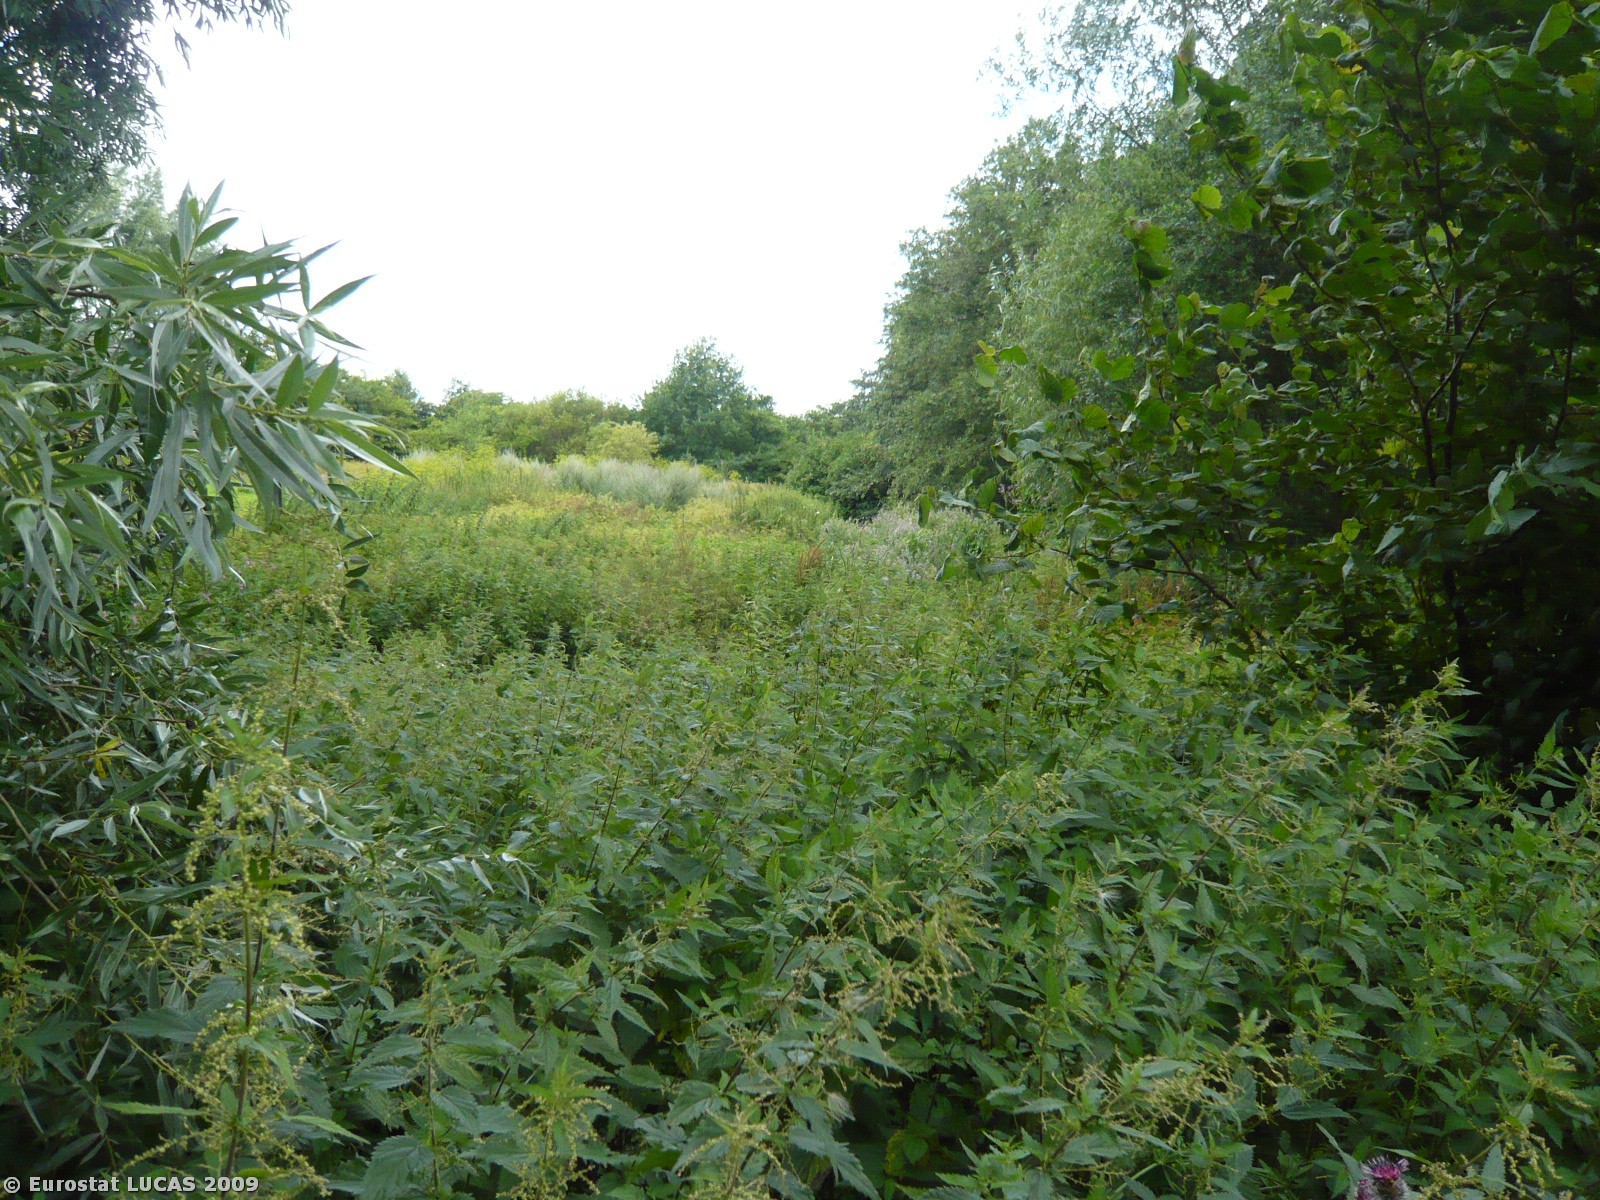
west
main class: Woodland
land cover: Broadleaved woodland
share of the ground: > 75 %
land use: Unused
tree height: < 5 m
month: July
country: DK
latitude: 55.4862
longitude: 12.1663
